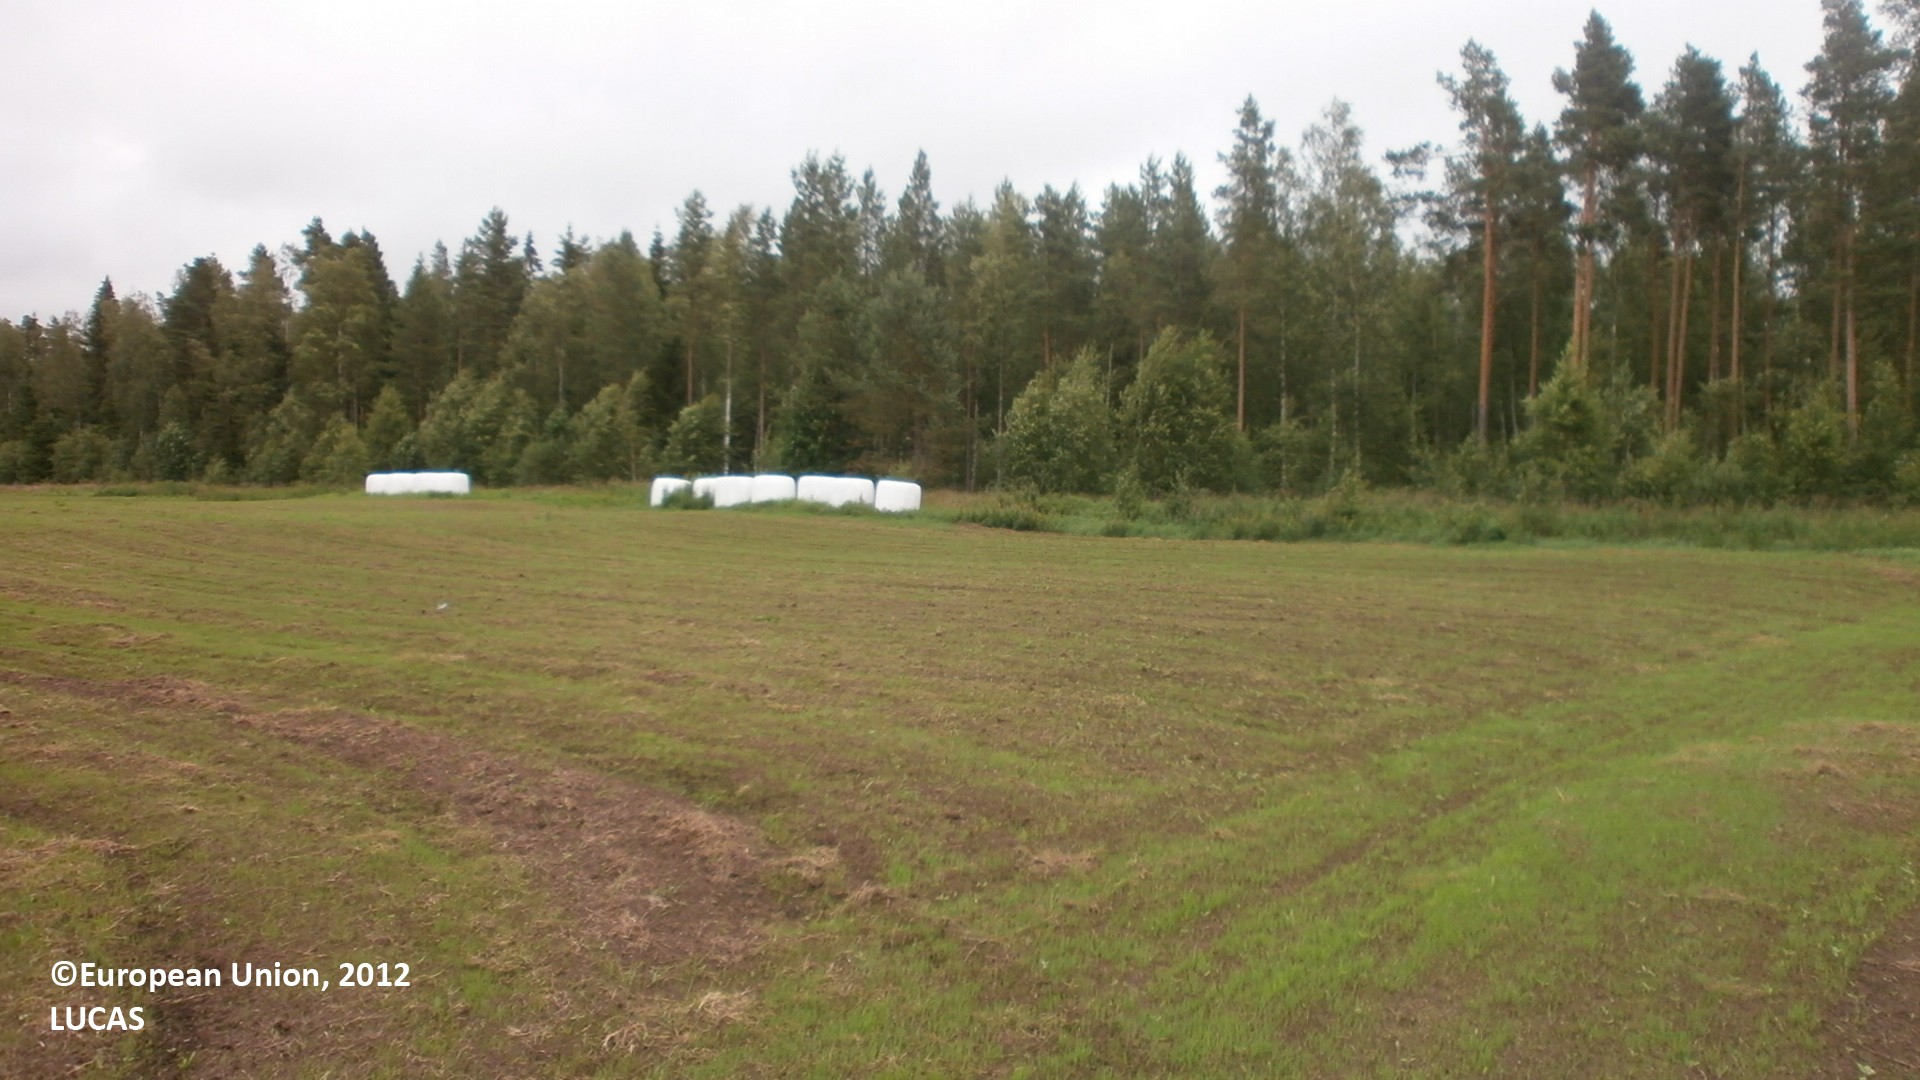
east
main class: Grassland
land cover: Grassland without tree/shrub cover
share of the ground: 10 - 25 %
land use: Agriculture (excluding fallow land and kitchen gardens)
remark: Harvested field
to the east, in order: Grassland without tree/shrub cover; Shruby margins; Ditches and canals; Shruby margins; Tracks; Shruby margins; Lines of trees; Ditches and canals; Pine dominated mixed woodland; Ditches and canals; Pine dominated mixed woodland; Pine dominated coniferous woodland; Ditches and canals; Spruce dominated coniferous woodland; Ditches and canals; Spruce dominated mixed woodland; Spruce dominated coniferous woodland
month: July
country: FI
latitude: 64.2670
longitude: 24.0386
